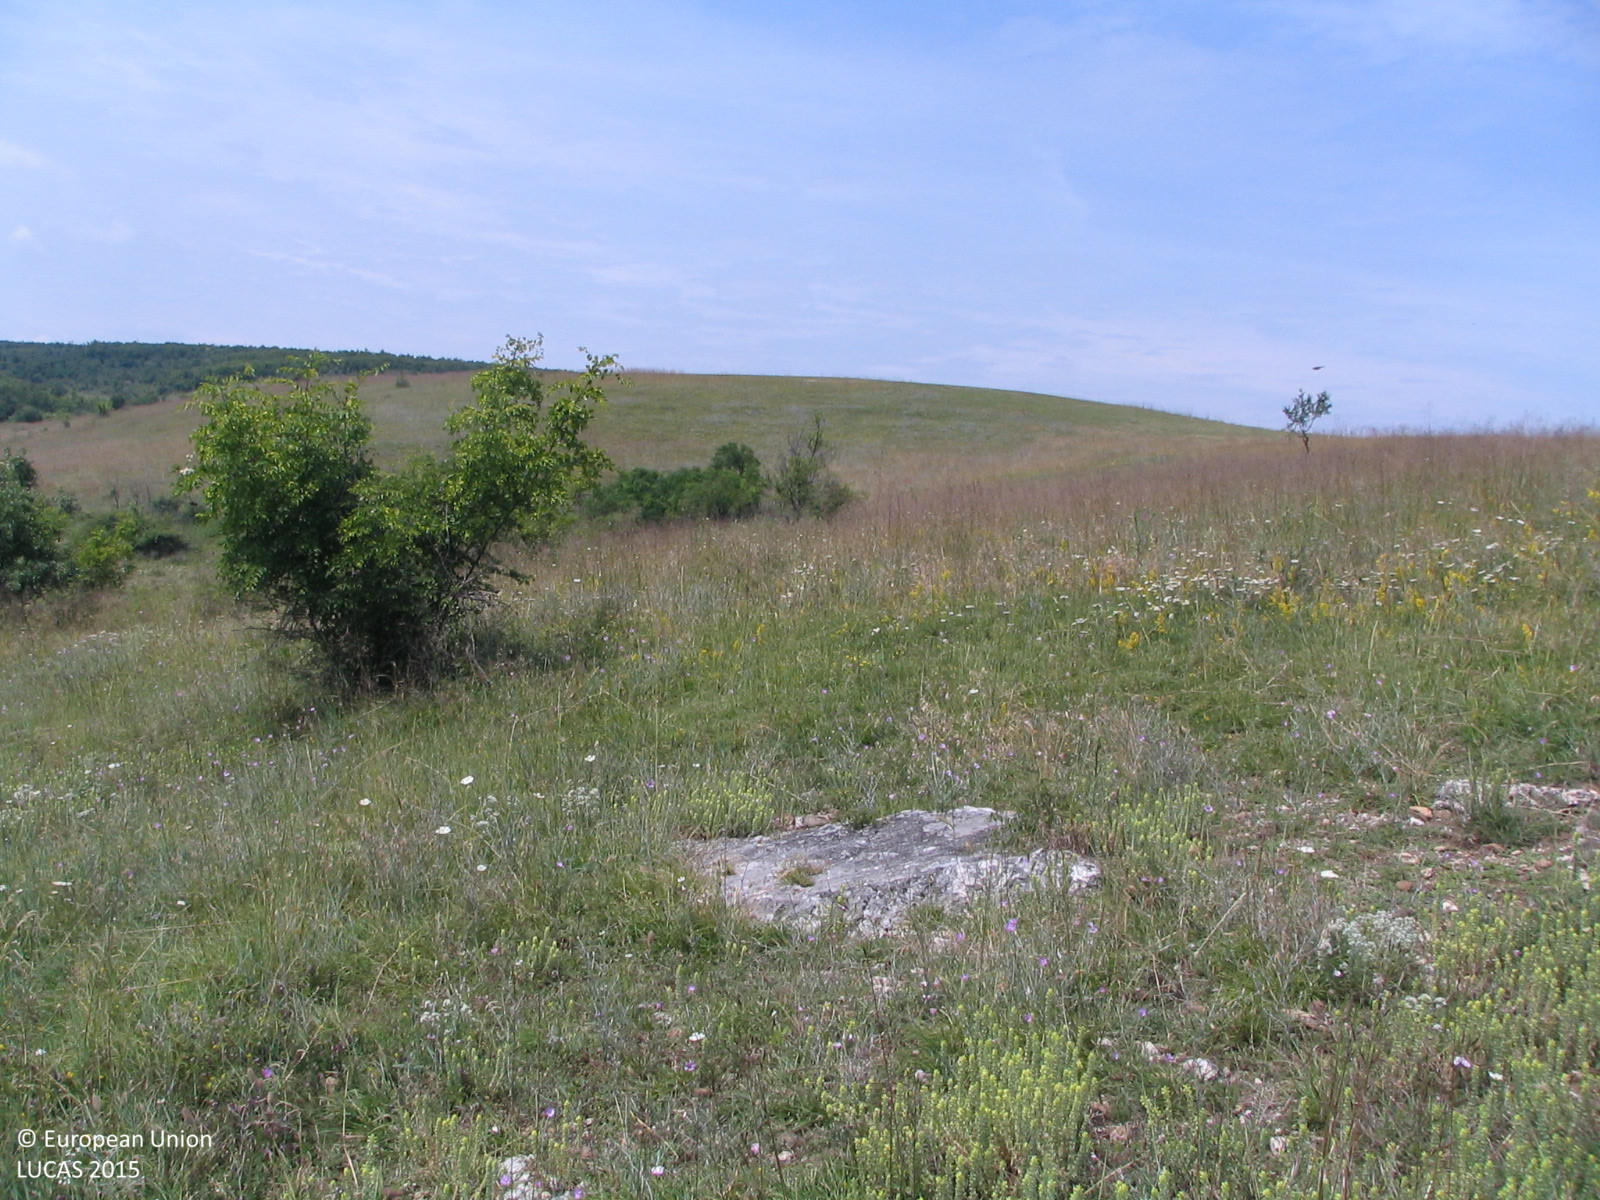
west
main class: Grassland
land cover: Grassland with sparse tree/shrub cover
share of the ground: > 75 %
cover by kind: herbaceous plants 85 %, shrubs 10 %, broadleaved forest trees 5 %
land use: Agriculture (excluding fallow land and kitchen gardens)
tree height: < 5 m
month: June
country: BG
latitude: 43.2811
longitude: 24.0379
